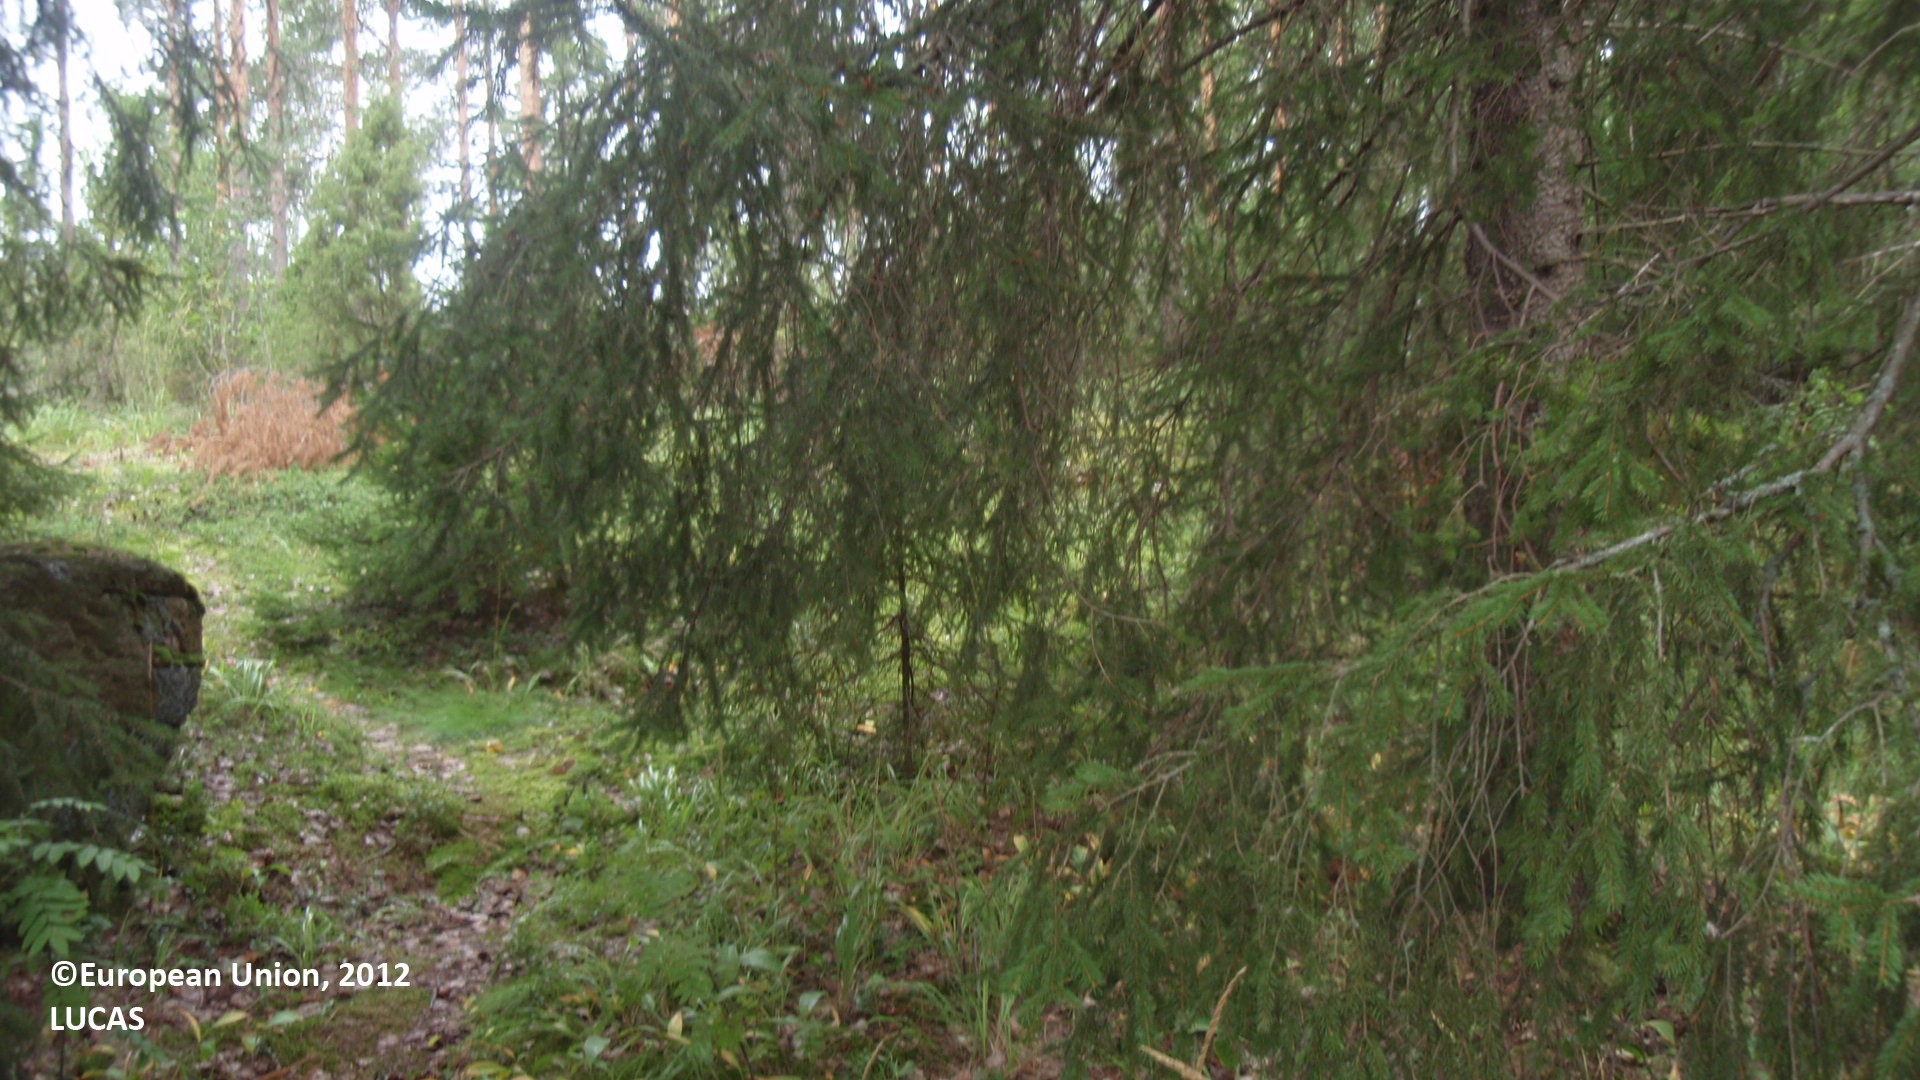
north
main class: Woodland
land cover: Spruce dominated mixed woodland
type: boreal forest
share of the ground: 50 - 75 %
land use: Forestry
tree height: > 5 m
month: August
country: FI
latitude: 61.0062
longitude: 26.6723
